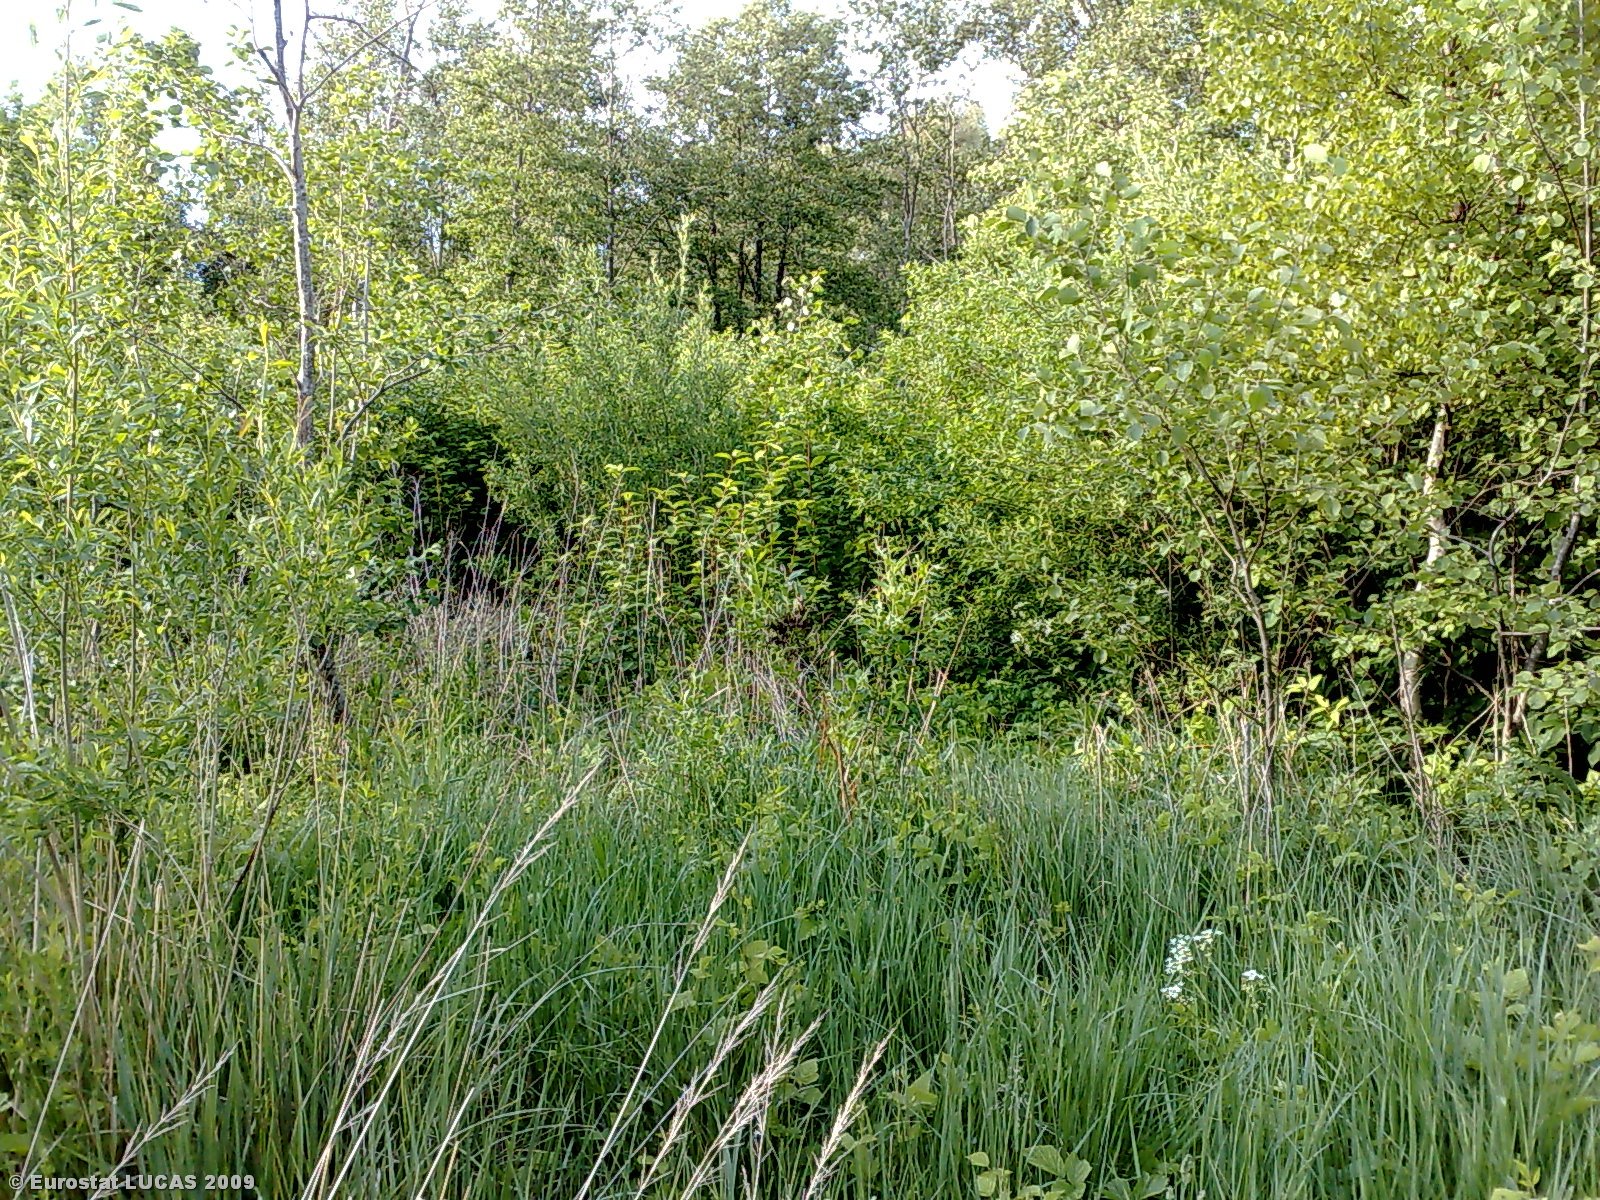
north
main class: Cropland
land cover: Rape and turnip rape
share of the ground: > 75 %
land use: Agriculture (excluding fallow land and kitchen gardens)
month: June
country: LT
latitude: 56.1277
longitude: 24.0028
